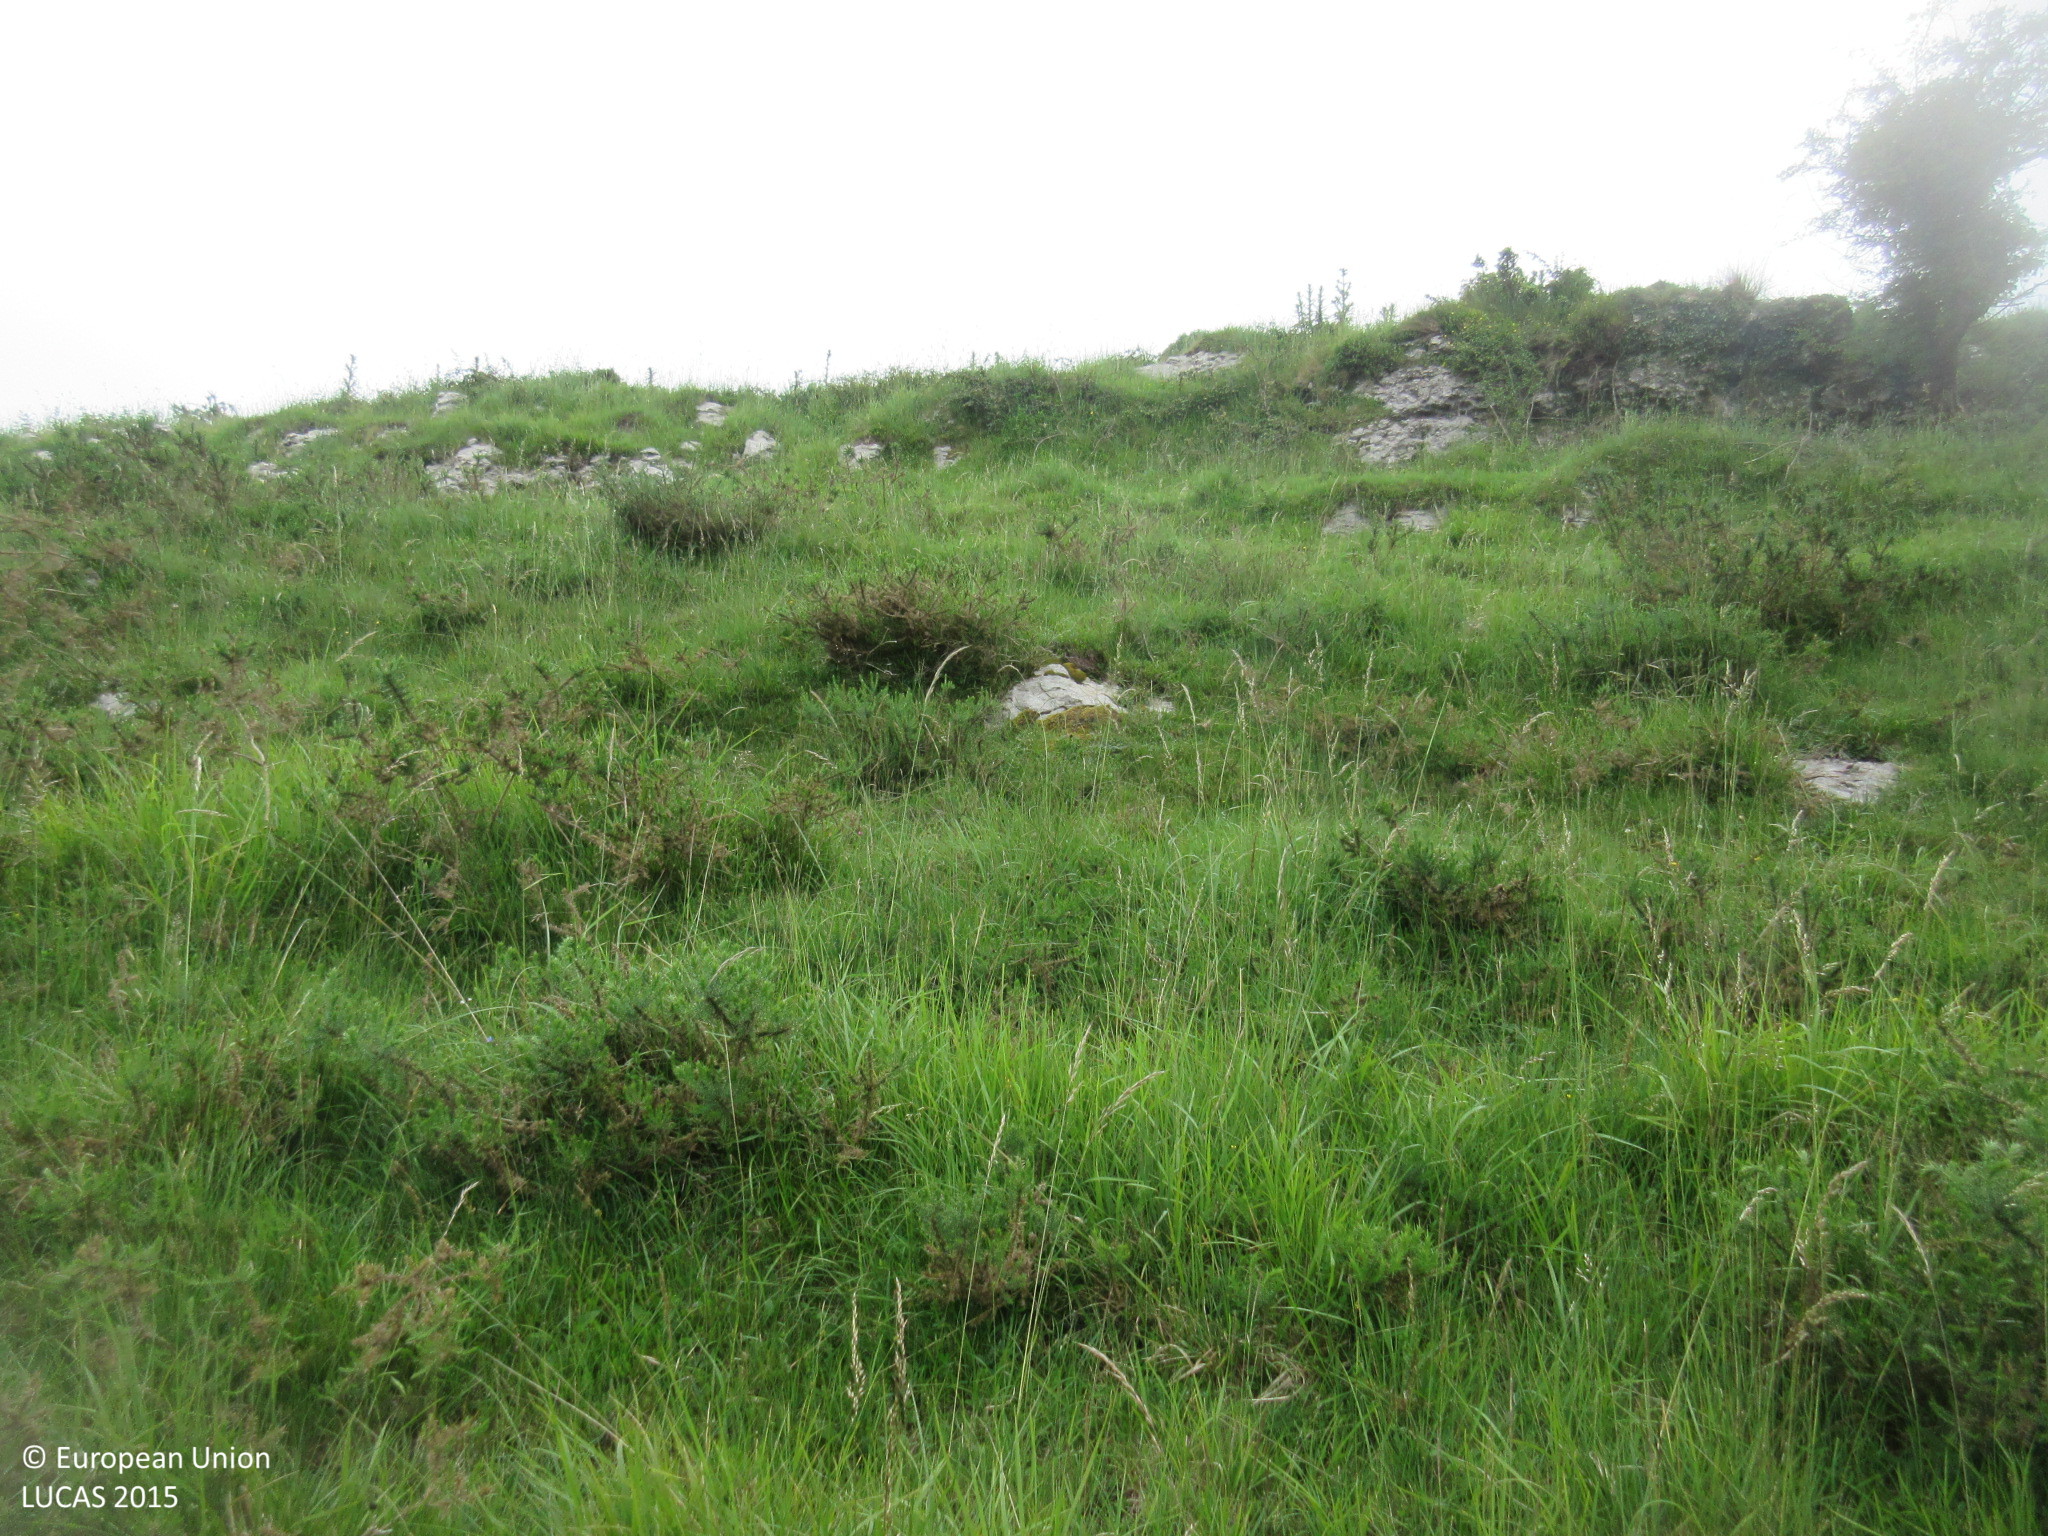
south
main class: Grassland
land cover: Grassland without tree/shrub cover
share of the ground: > 75 %
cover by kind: herbaceous plants 95 %, shrubs 5 %
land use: Agriculture (excluding fallow land and kitchen gardens)
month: June
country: ES
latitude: 43.3052
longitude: -3.5926
